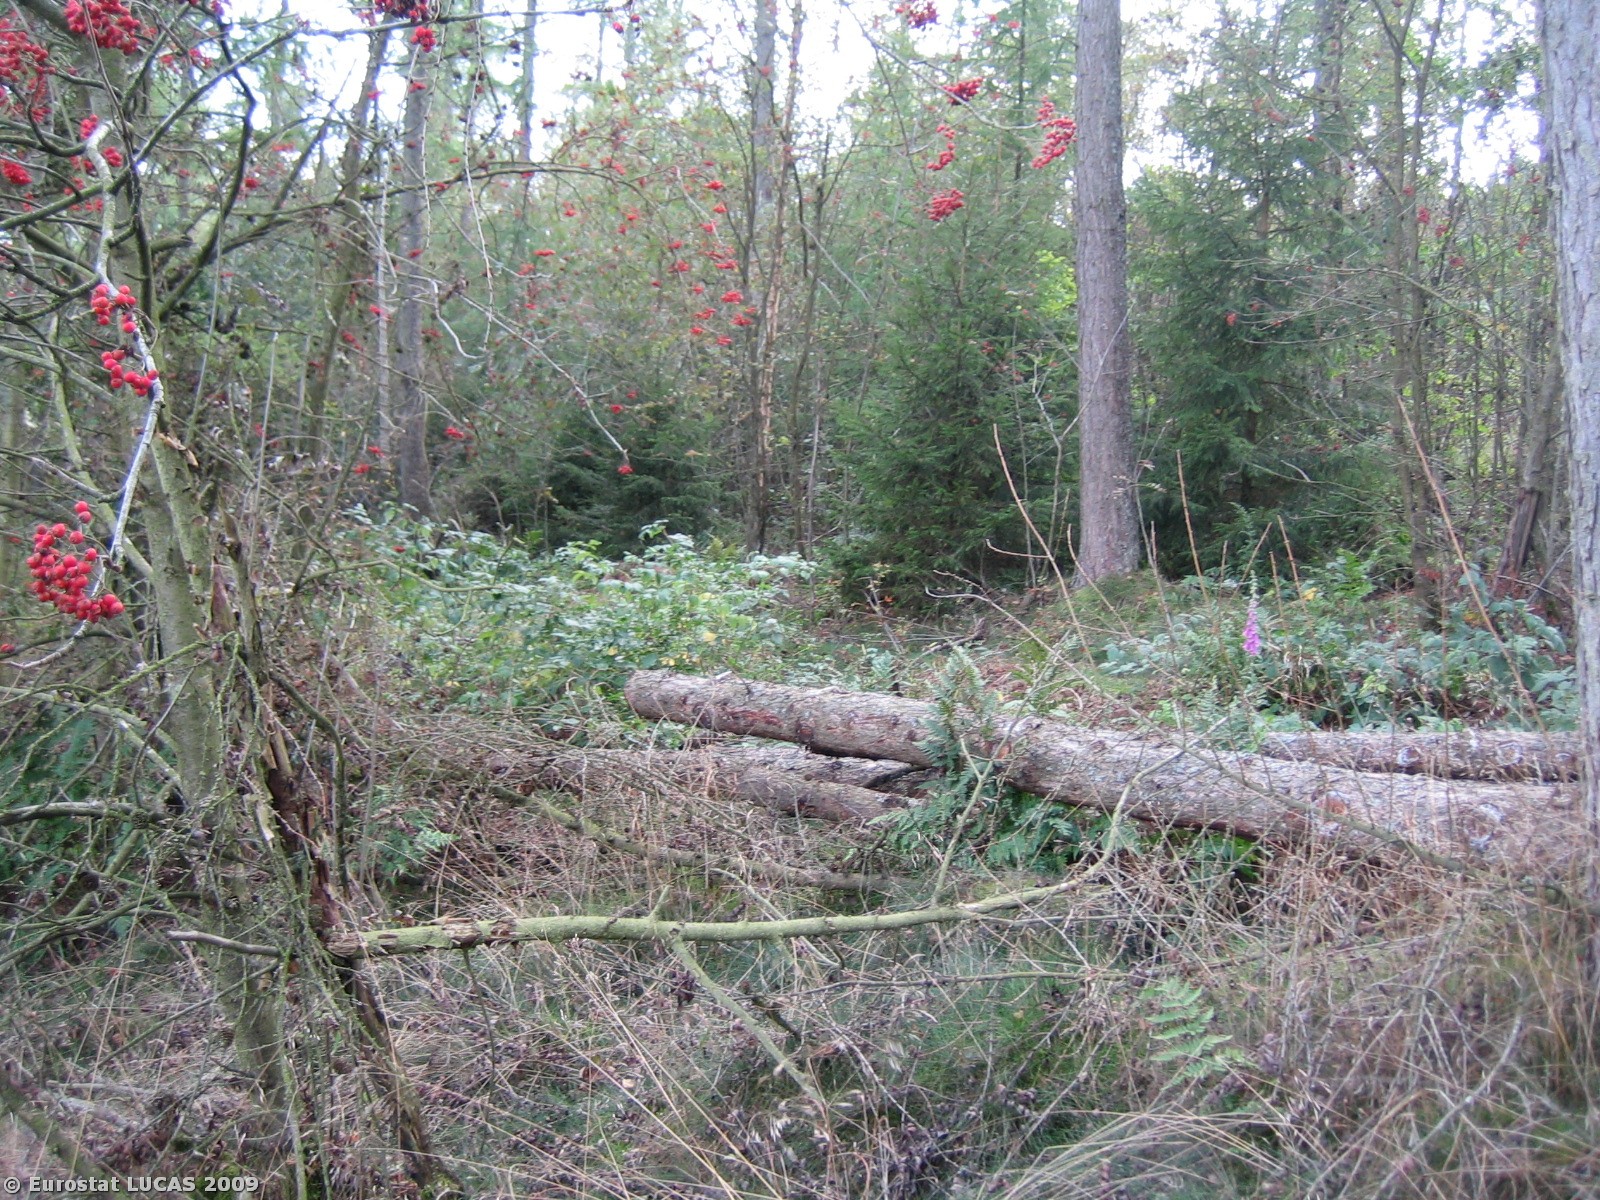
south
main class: Grassland
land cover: Grassland without tree/shrub cover
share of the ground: > 75 %
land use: Agriculture (excluding fallow land and kitchen gardens)
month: September
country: BE
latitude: 50.1182
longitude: 5.6210
